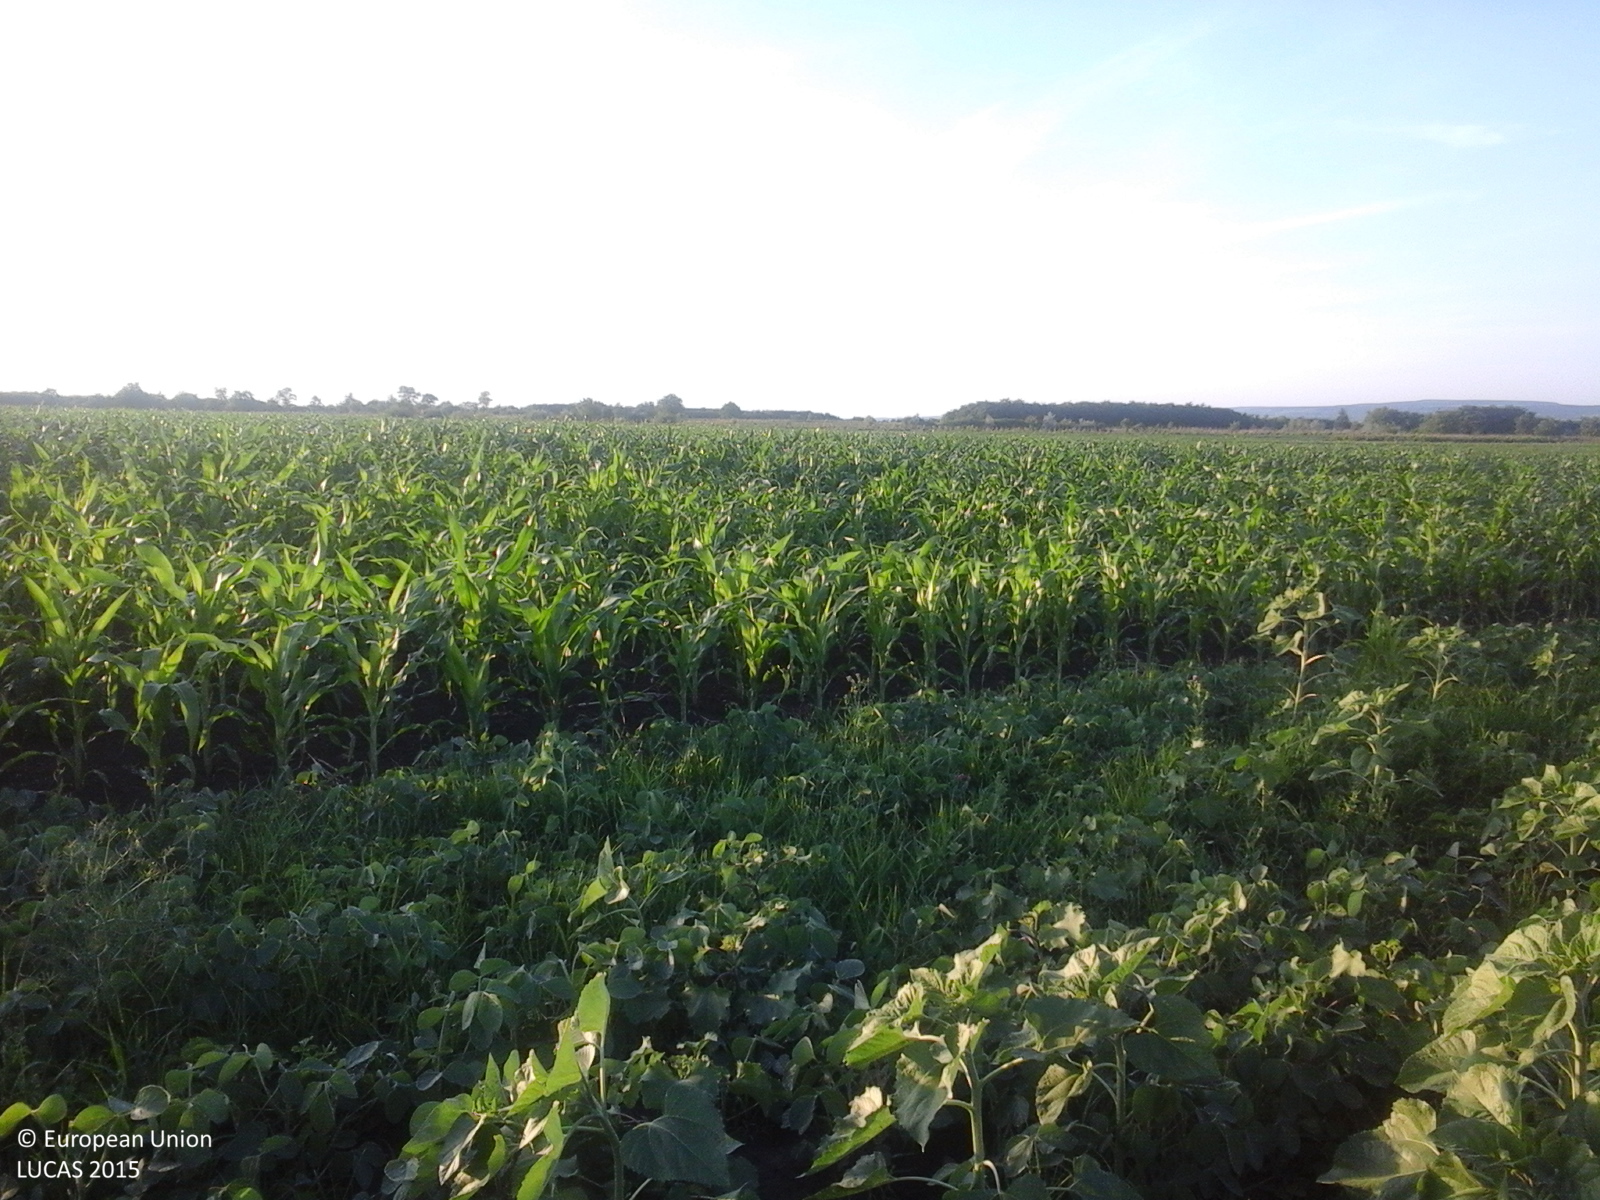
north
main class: Cropland
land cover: Sunflower
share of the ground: 50 - 75 %
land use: Agriculture (excluding fallow land and kitchen gardens)
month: June
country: RO
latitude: 47.7161
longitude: 27.2406
